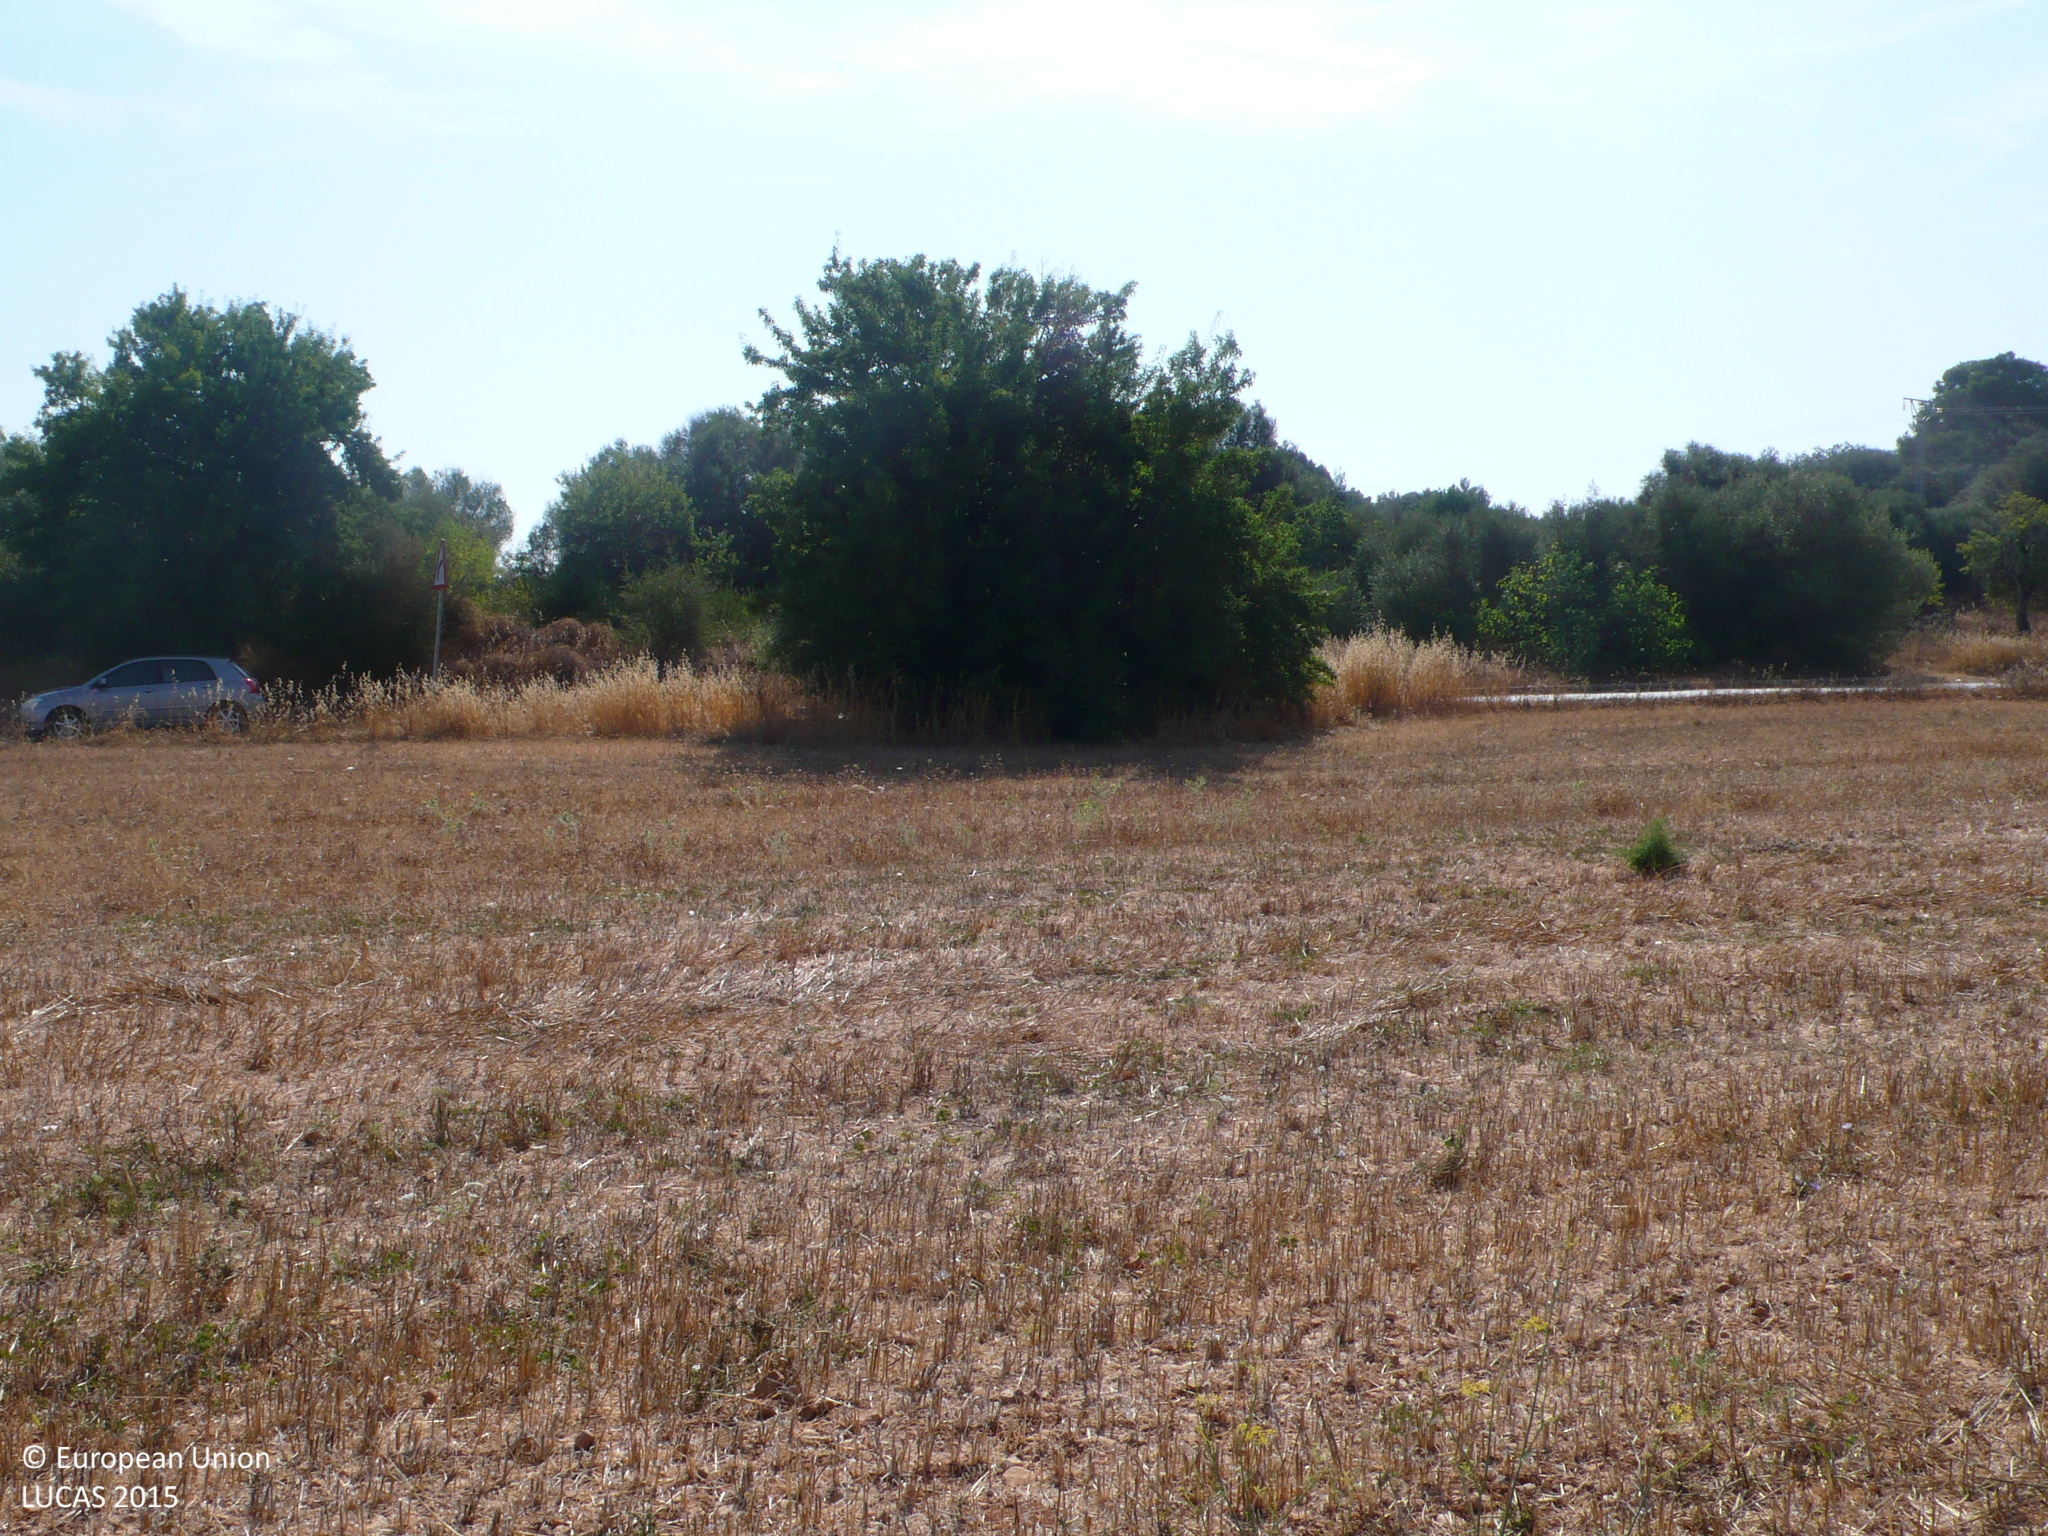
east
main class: Cropland
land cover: Barley
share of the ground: < 10 %
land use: Agriculture (excluding fallow land and kitchen gardens)
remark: Harvested field
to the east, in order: Barley; Single bushes/trees; Paved roads, cycling and walking lanes; Shrubland with sparse tree cover; Broadleaved woodland; Dry stone walls; Barley; Lines of trees; Spontaneously vegetated surfaces; Broadleaved woodland; Other fresh vegetables; Single bushes/trees; Electric lines; Tracks; Barley
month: July
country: ES
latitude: 39.5554
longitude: 2.8962
